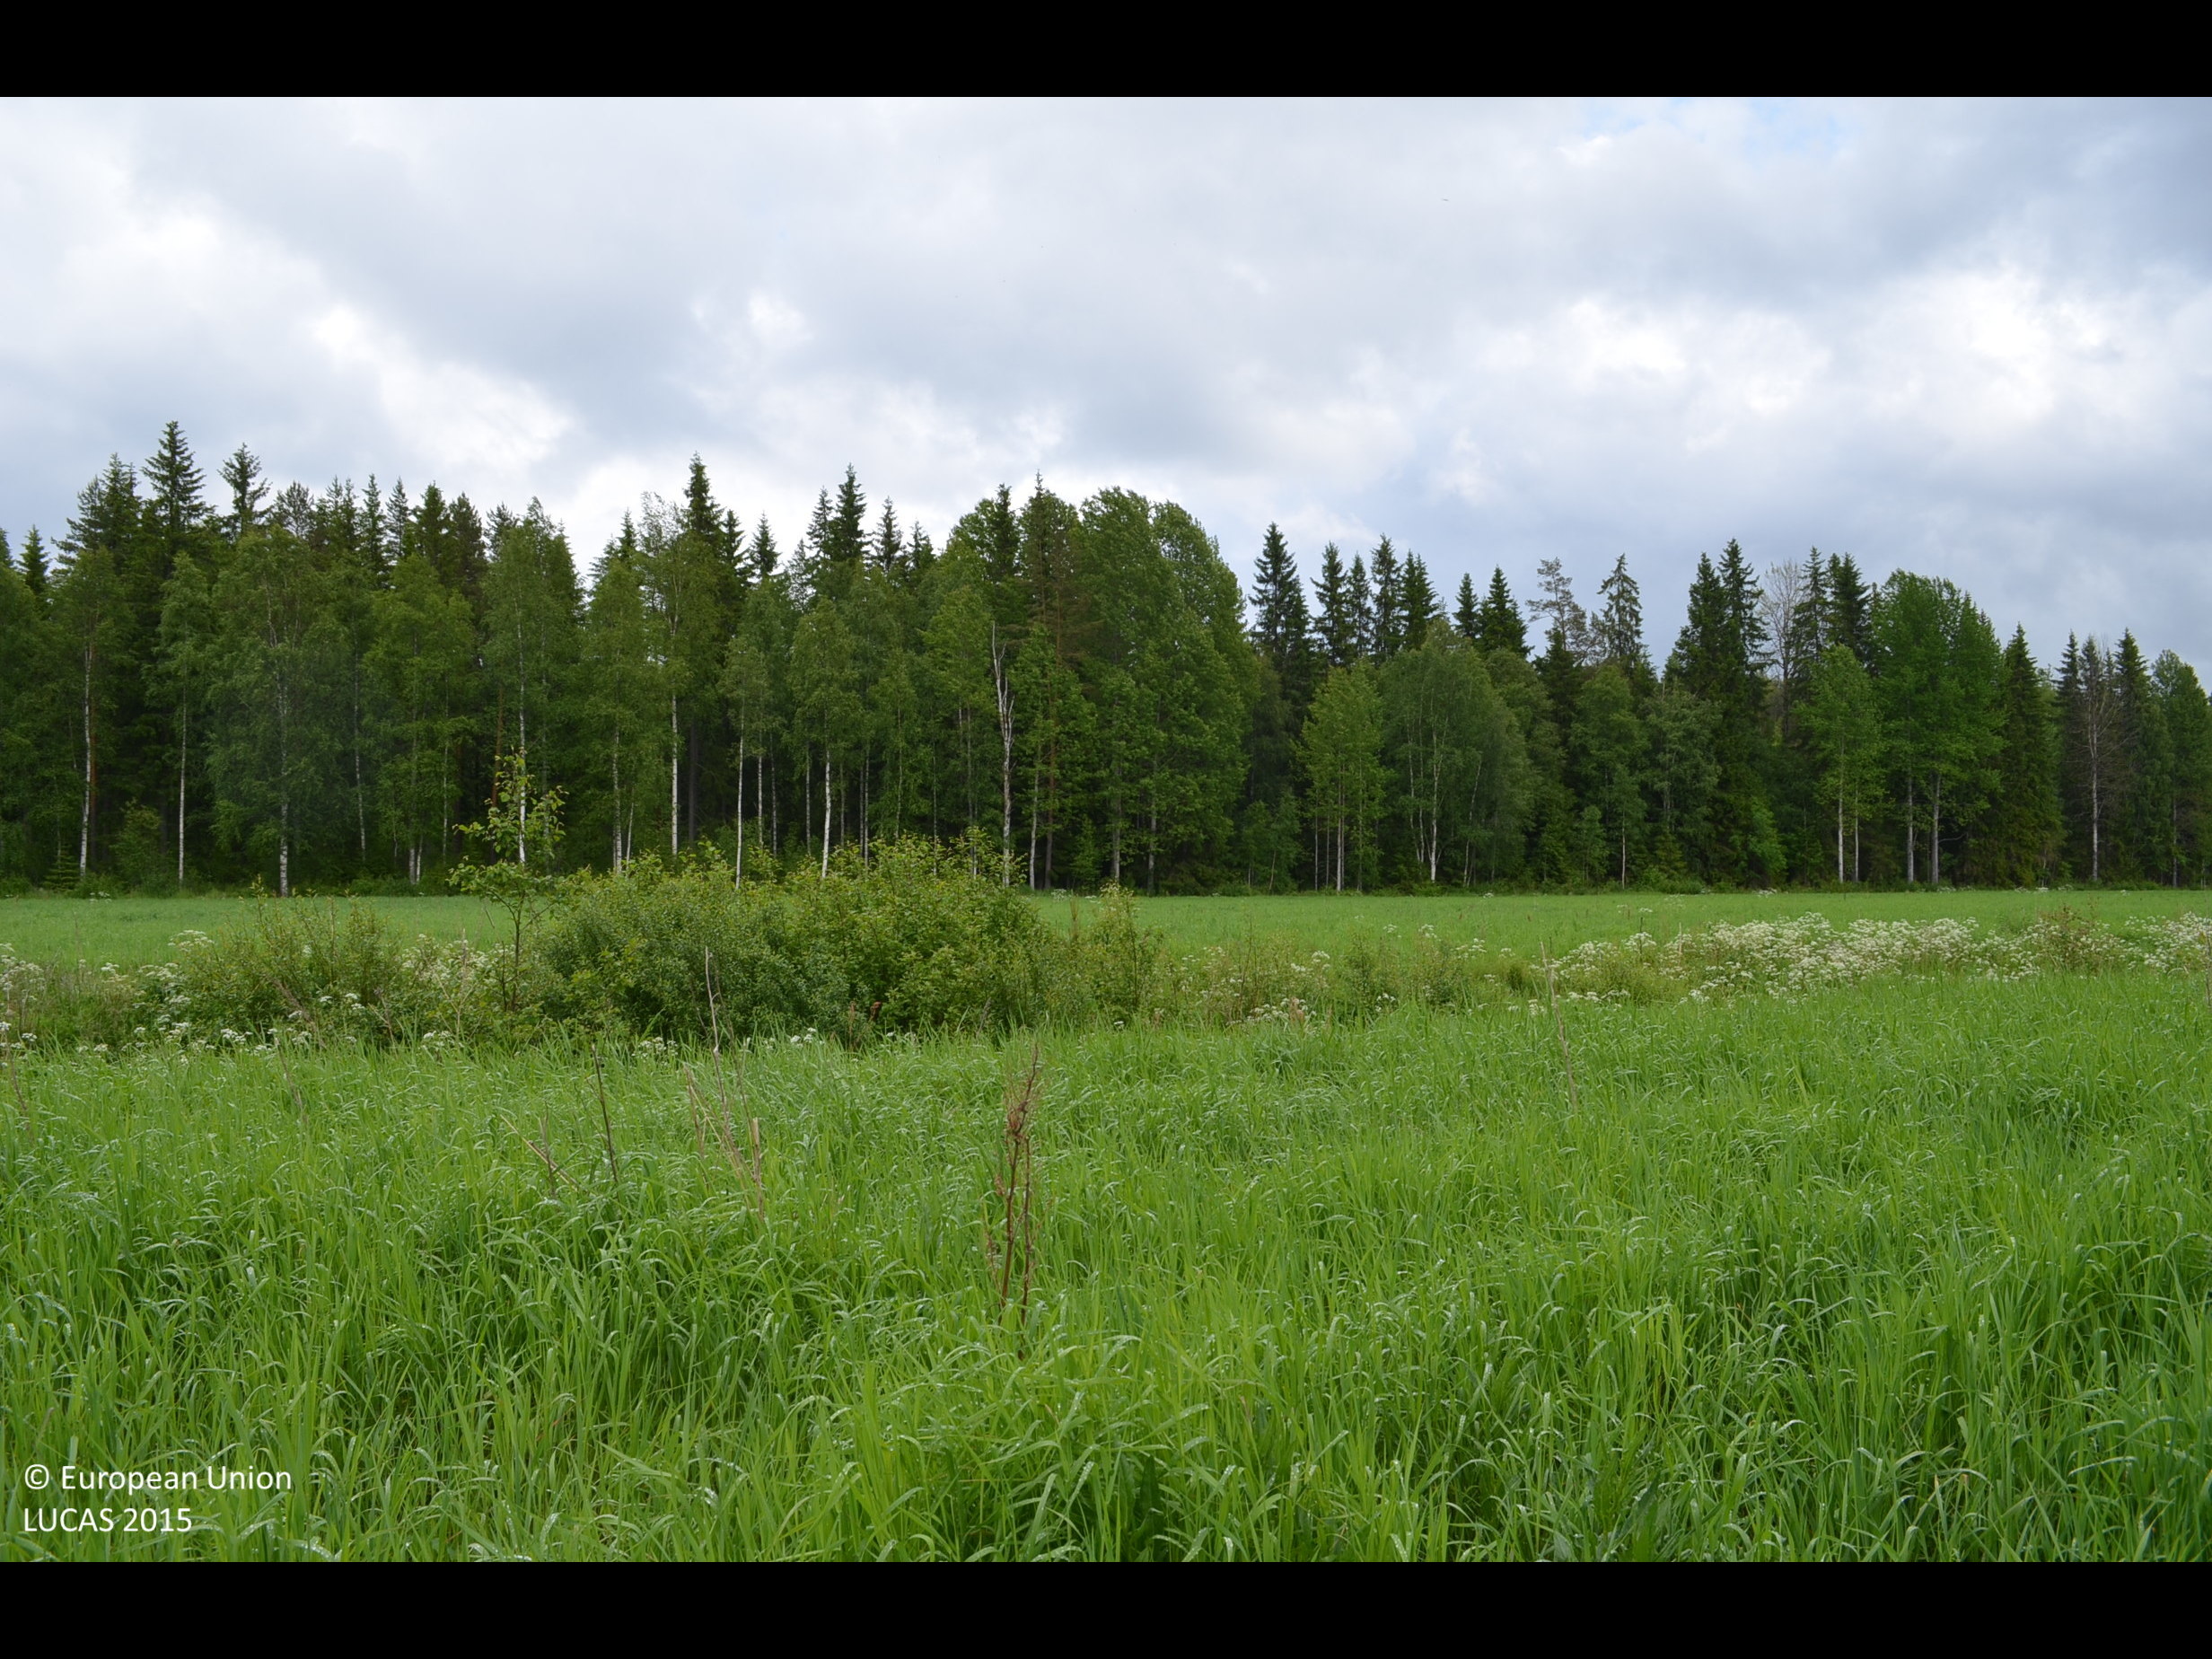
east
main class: Cropland
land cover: Temporary grasslands
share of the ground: > 75 %
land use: Agriculture (excluding fallow land and kitchen gardens)
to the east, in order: Temporary grasslands; Ditches and canals; Temporary grasslands; Abandoned hedges; Ditches and canals; Other mixed woodland; Spruce dominated mixed woodland
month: June
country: FI
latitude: 61.7432
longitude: 23.3095
